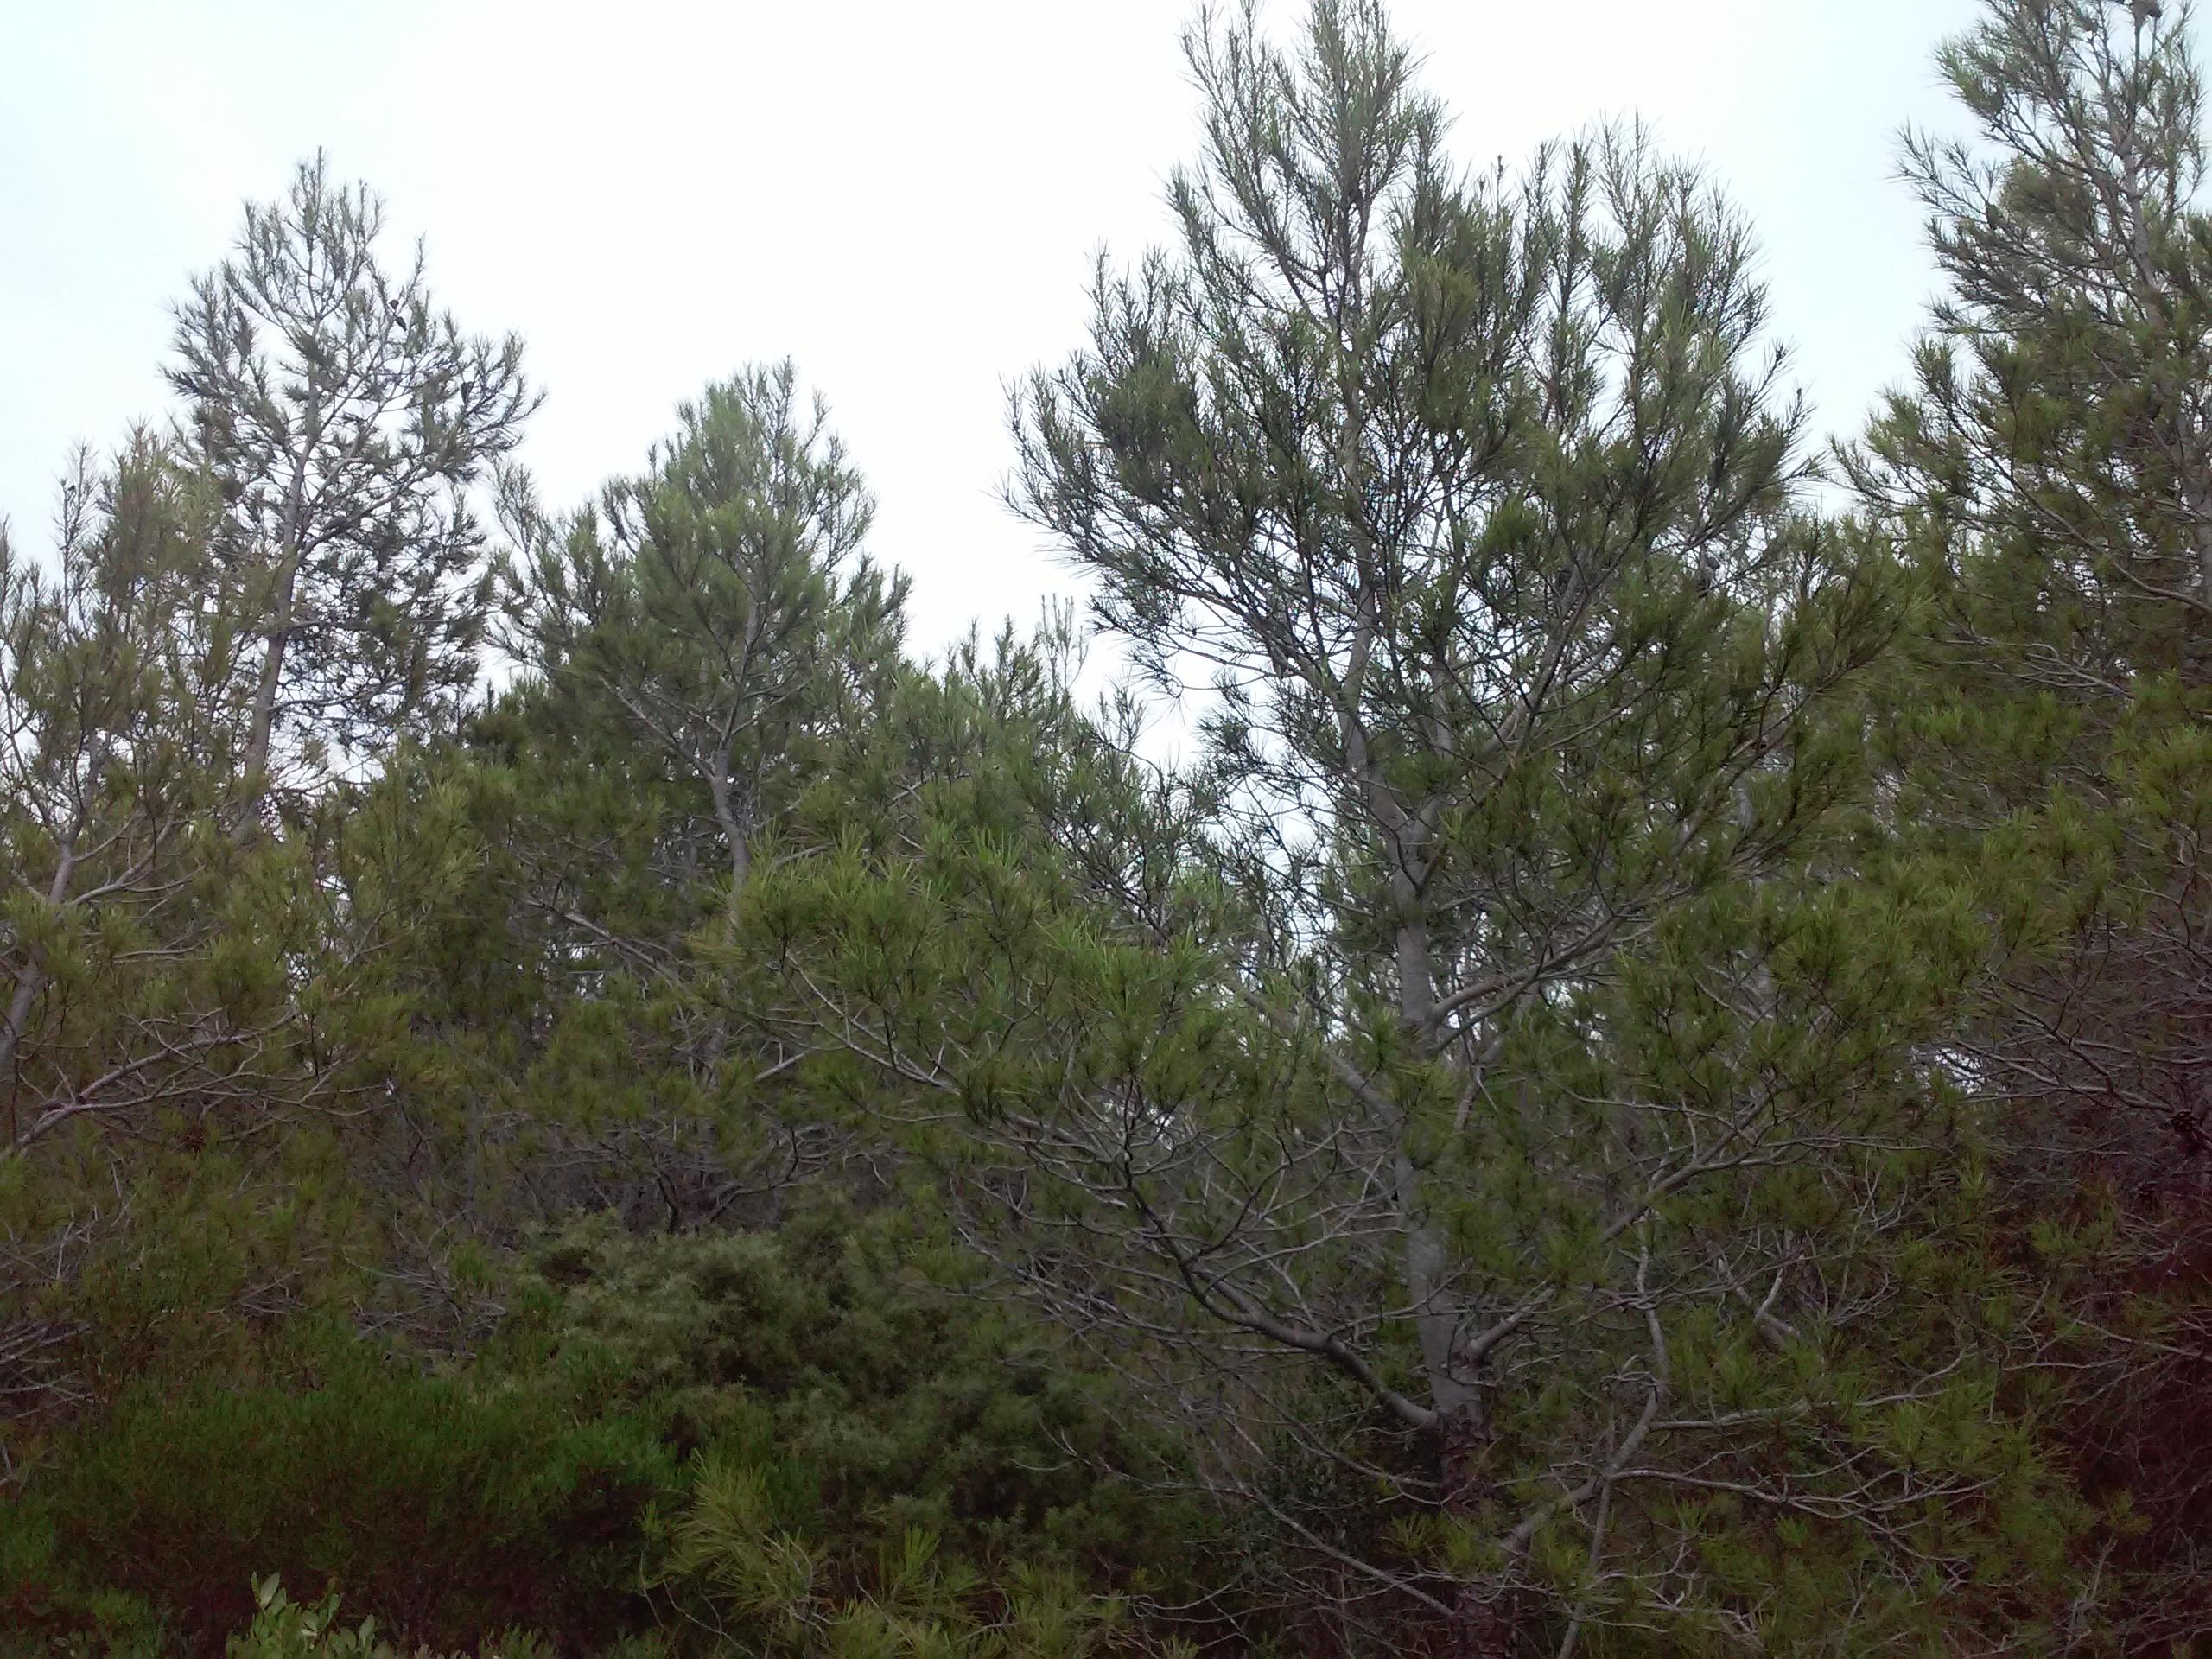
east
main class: Woodland
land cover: Pine dominated coniferous woodland
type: coniferous forest of the mediterranean region
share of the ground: 10 - 25 %
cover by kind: shrubs 50 %, coniferous forest trees 30 %, herbaceous plants 20 %
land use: Semi-natural and natural areas not in use
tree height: < 5 m
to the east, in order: Pine dominated coniferous woodland; Shrubland with sparse tree cover; Pine dominated coniferous woodland; Olive groves; Dry stone walls; Shruby margins; Dry stone walls; Shrubland with sparse tree cover; Pine dominated coniferous woodland; Shrubland with sparse tree cover
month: August
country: ES
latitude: 41.0440
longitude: 0.5104
